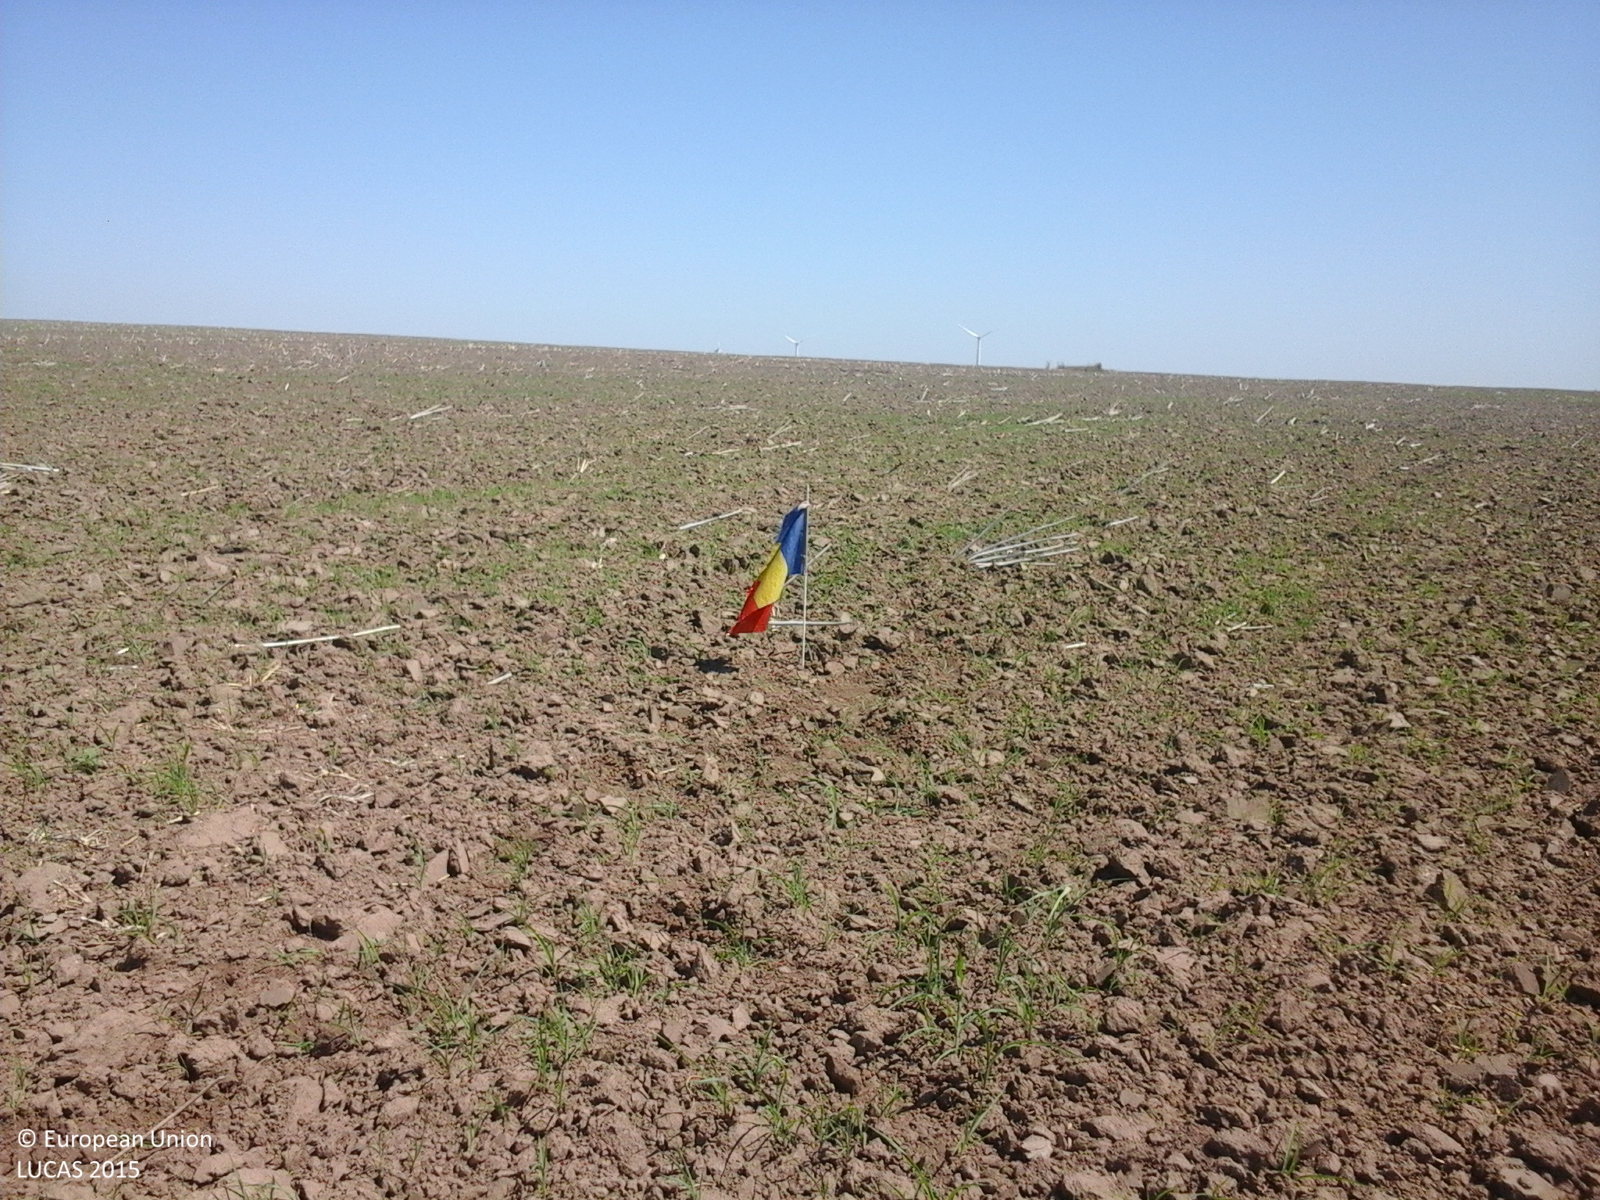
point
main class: Cropland
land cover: Rape and turnip rape
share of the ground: < 10 %
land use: Agriculture (excluding fallow land and kitchen gardens)
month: August
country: RO
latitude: 44.6595
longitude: 28.1091
